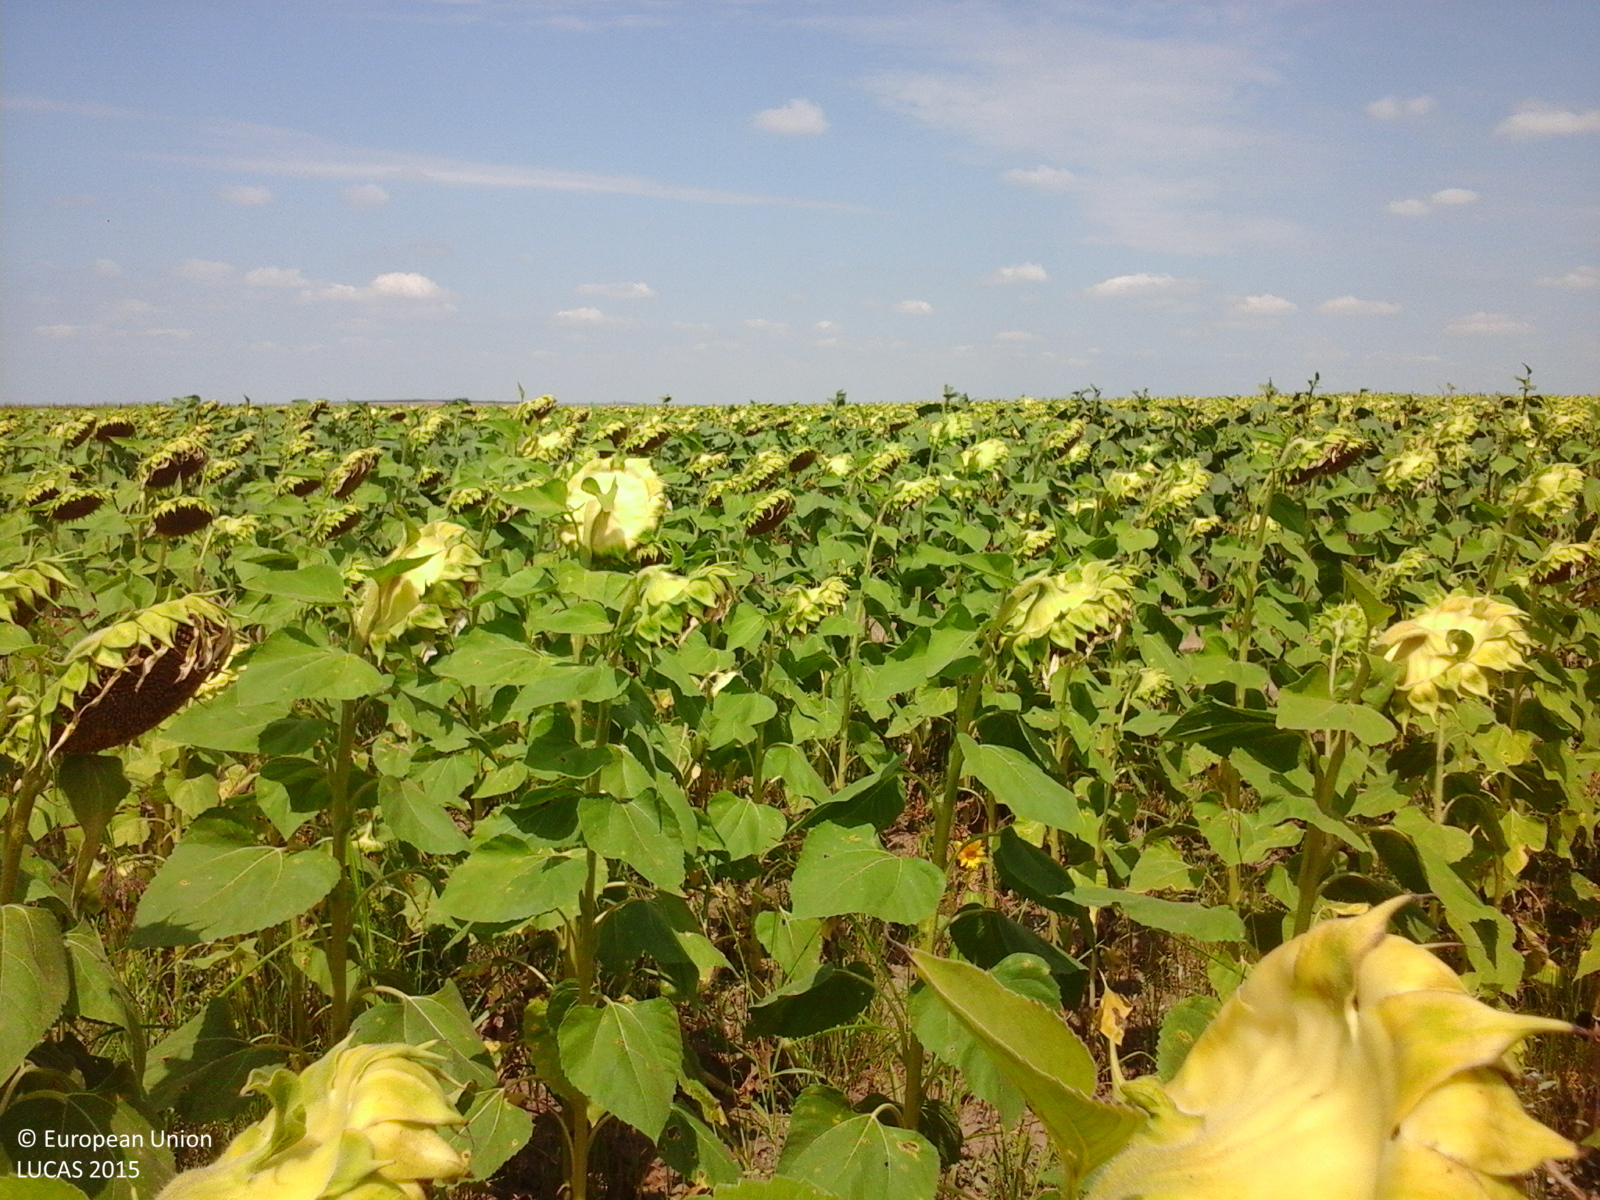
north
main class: Cropland
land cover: Sunflower
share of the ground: > 75 %
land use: Agriculture (excluding fallow land and kitchen gardens)
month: August
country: RO
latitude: 44.8076
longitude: 28.2105
